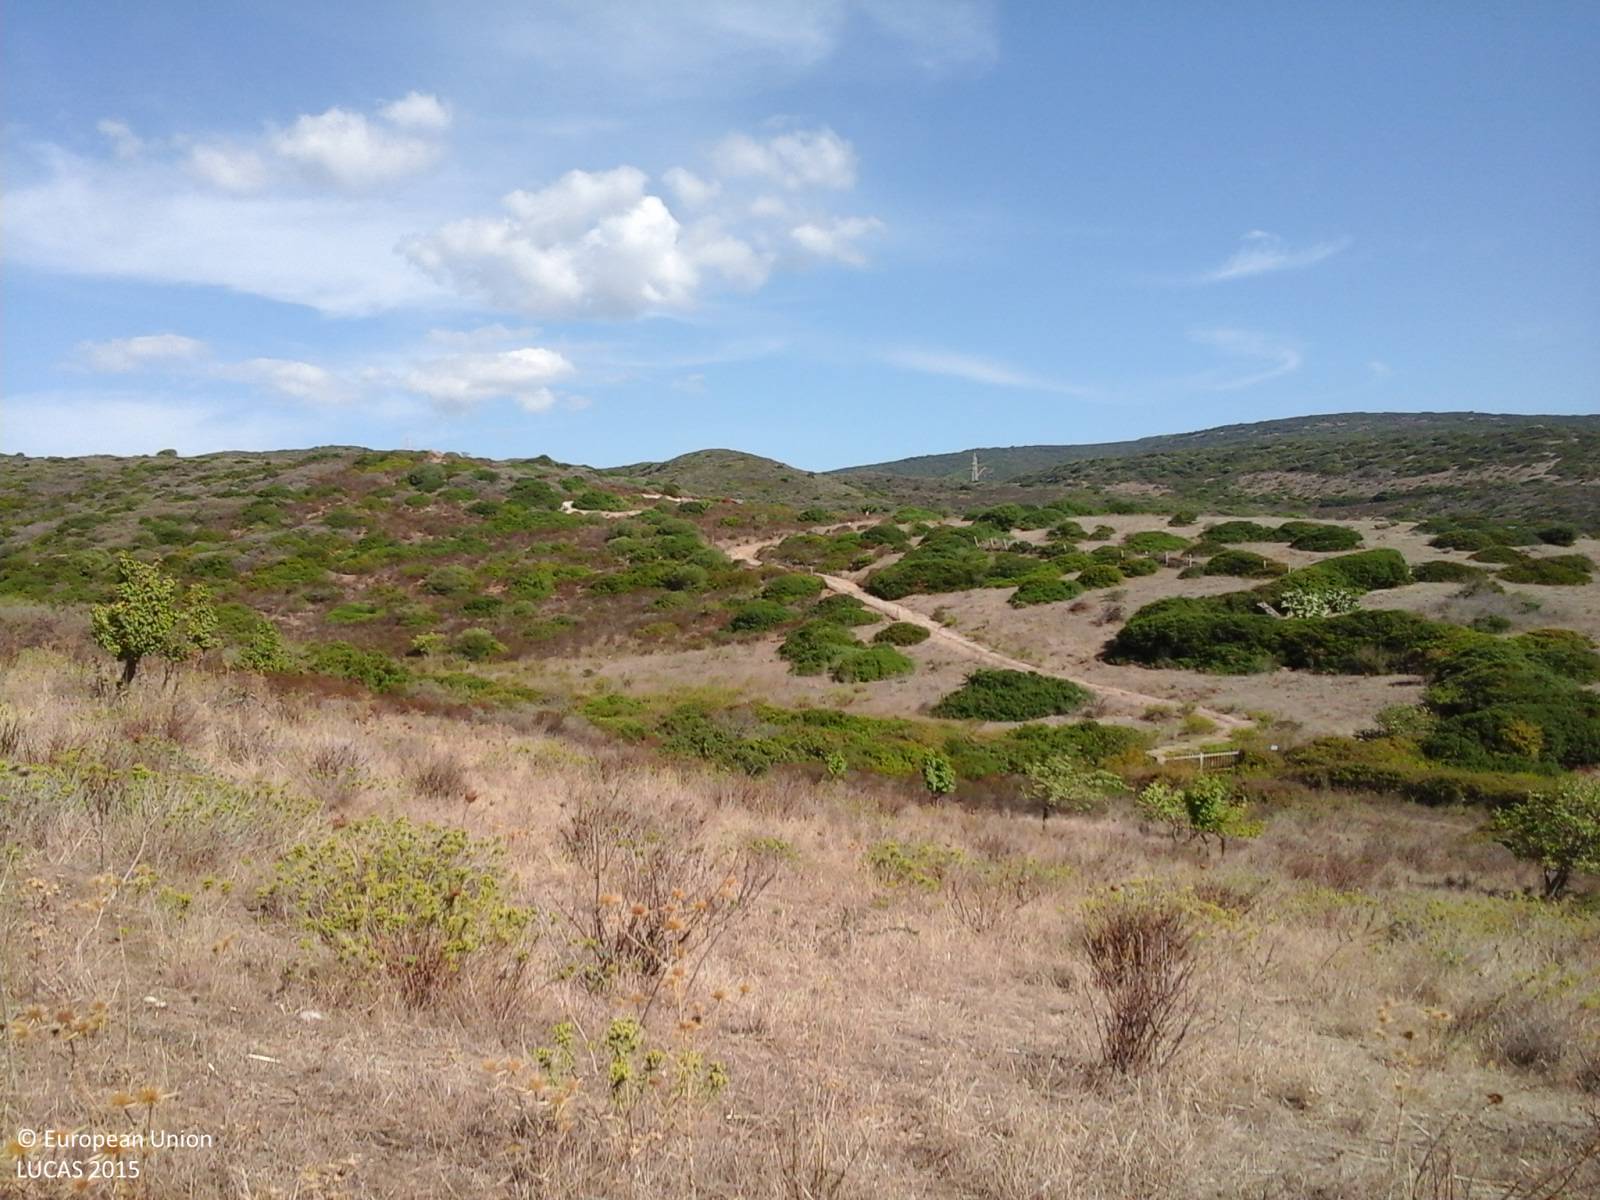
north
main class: Grassland
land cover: Grassland with sparse tree/shrub cover
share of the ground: > 75 %
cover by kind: herbaceous plants 90 %, broadleaved forest trees 5 %, shrubs 5 %
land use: Agriculture (excluding fallow land and kitchen gardens)
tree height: < 5 m
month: September
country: IT
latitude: 40.0392
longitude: 8.5429
